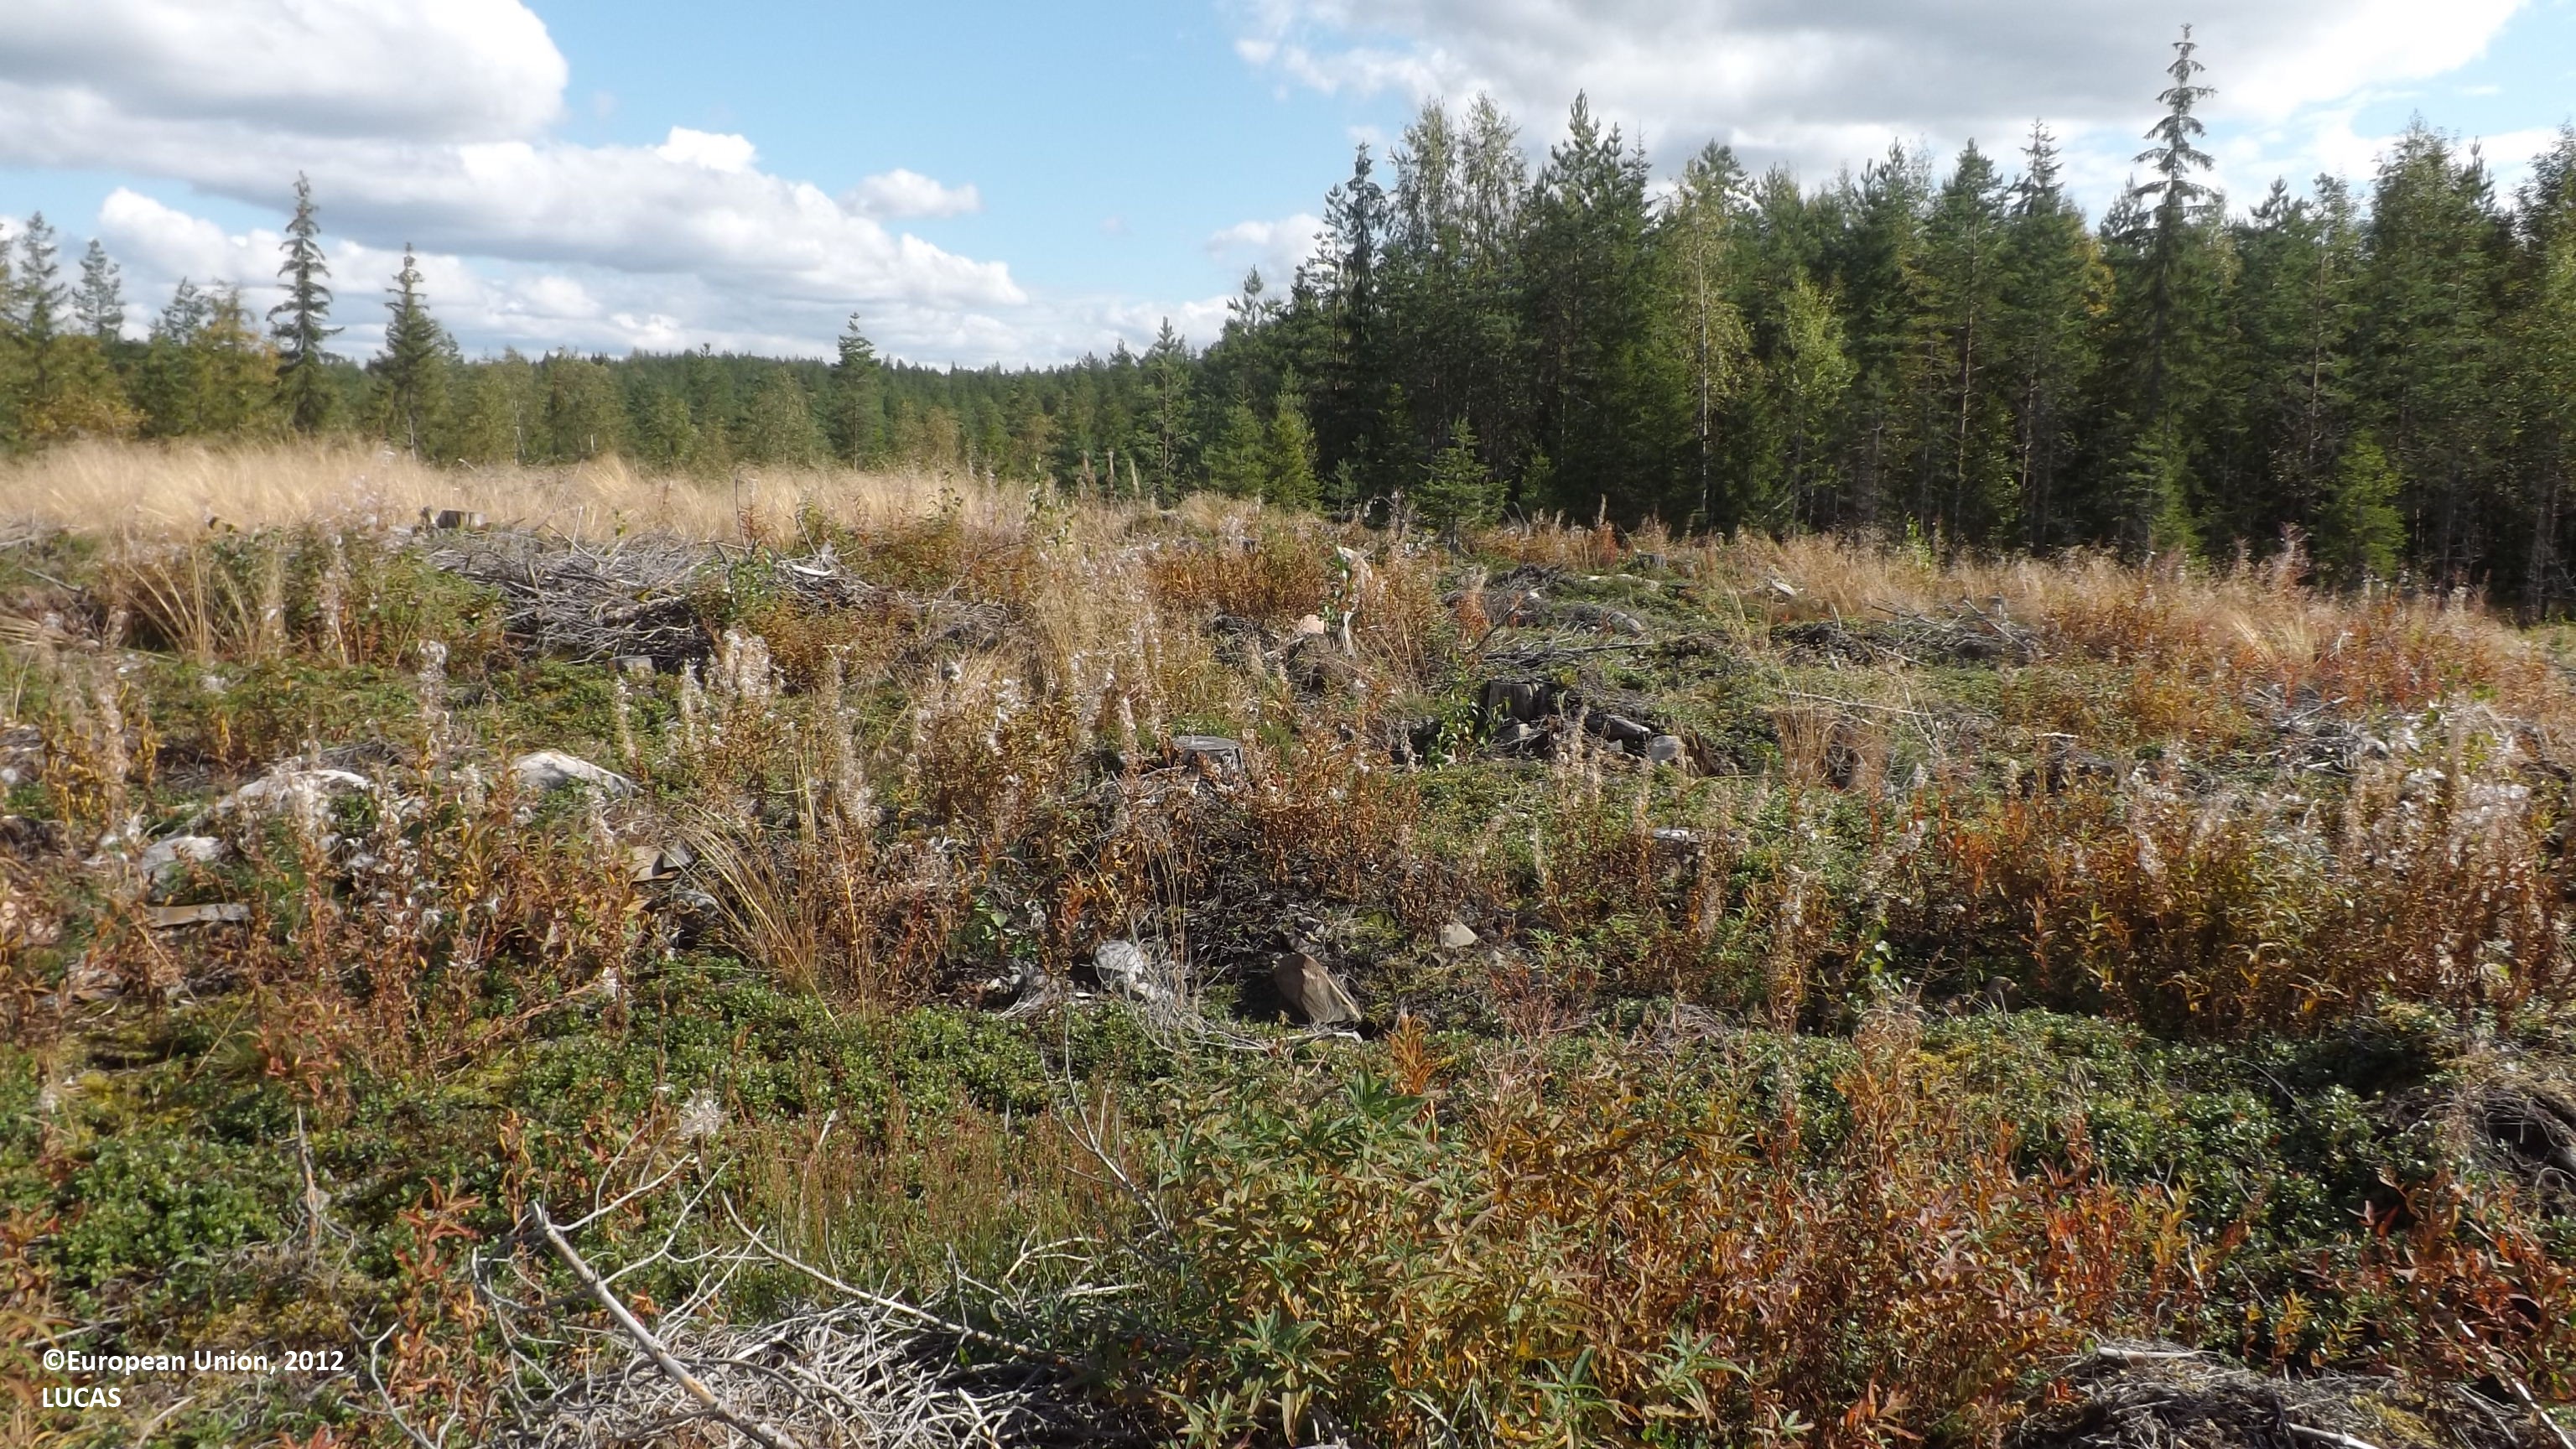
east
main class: Shrubland
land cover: Shrubland without tree cover
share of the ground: 25 - 50 %
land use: Forestry
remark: Clear cut
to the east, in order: Shrubland without tree cover; Grassland with sparse tree/shrub cover; Tracks; Other mixed woodland; Pine dominated mixed woodland; Other mixed woodland; Pine dominated mixed woodland; Pine dominated coniferous woodland; Pine dominated mixed woodland; Pine dominated coniferous woodland; Pine dominated mixed woodland
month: August
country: FI
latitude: 63.6466
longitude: 23.5696
